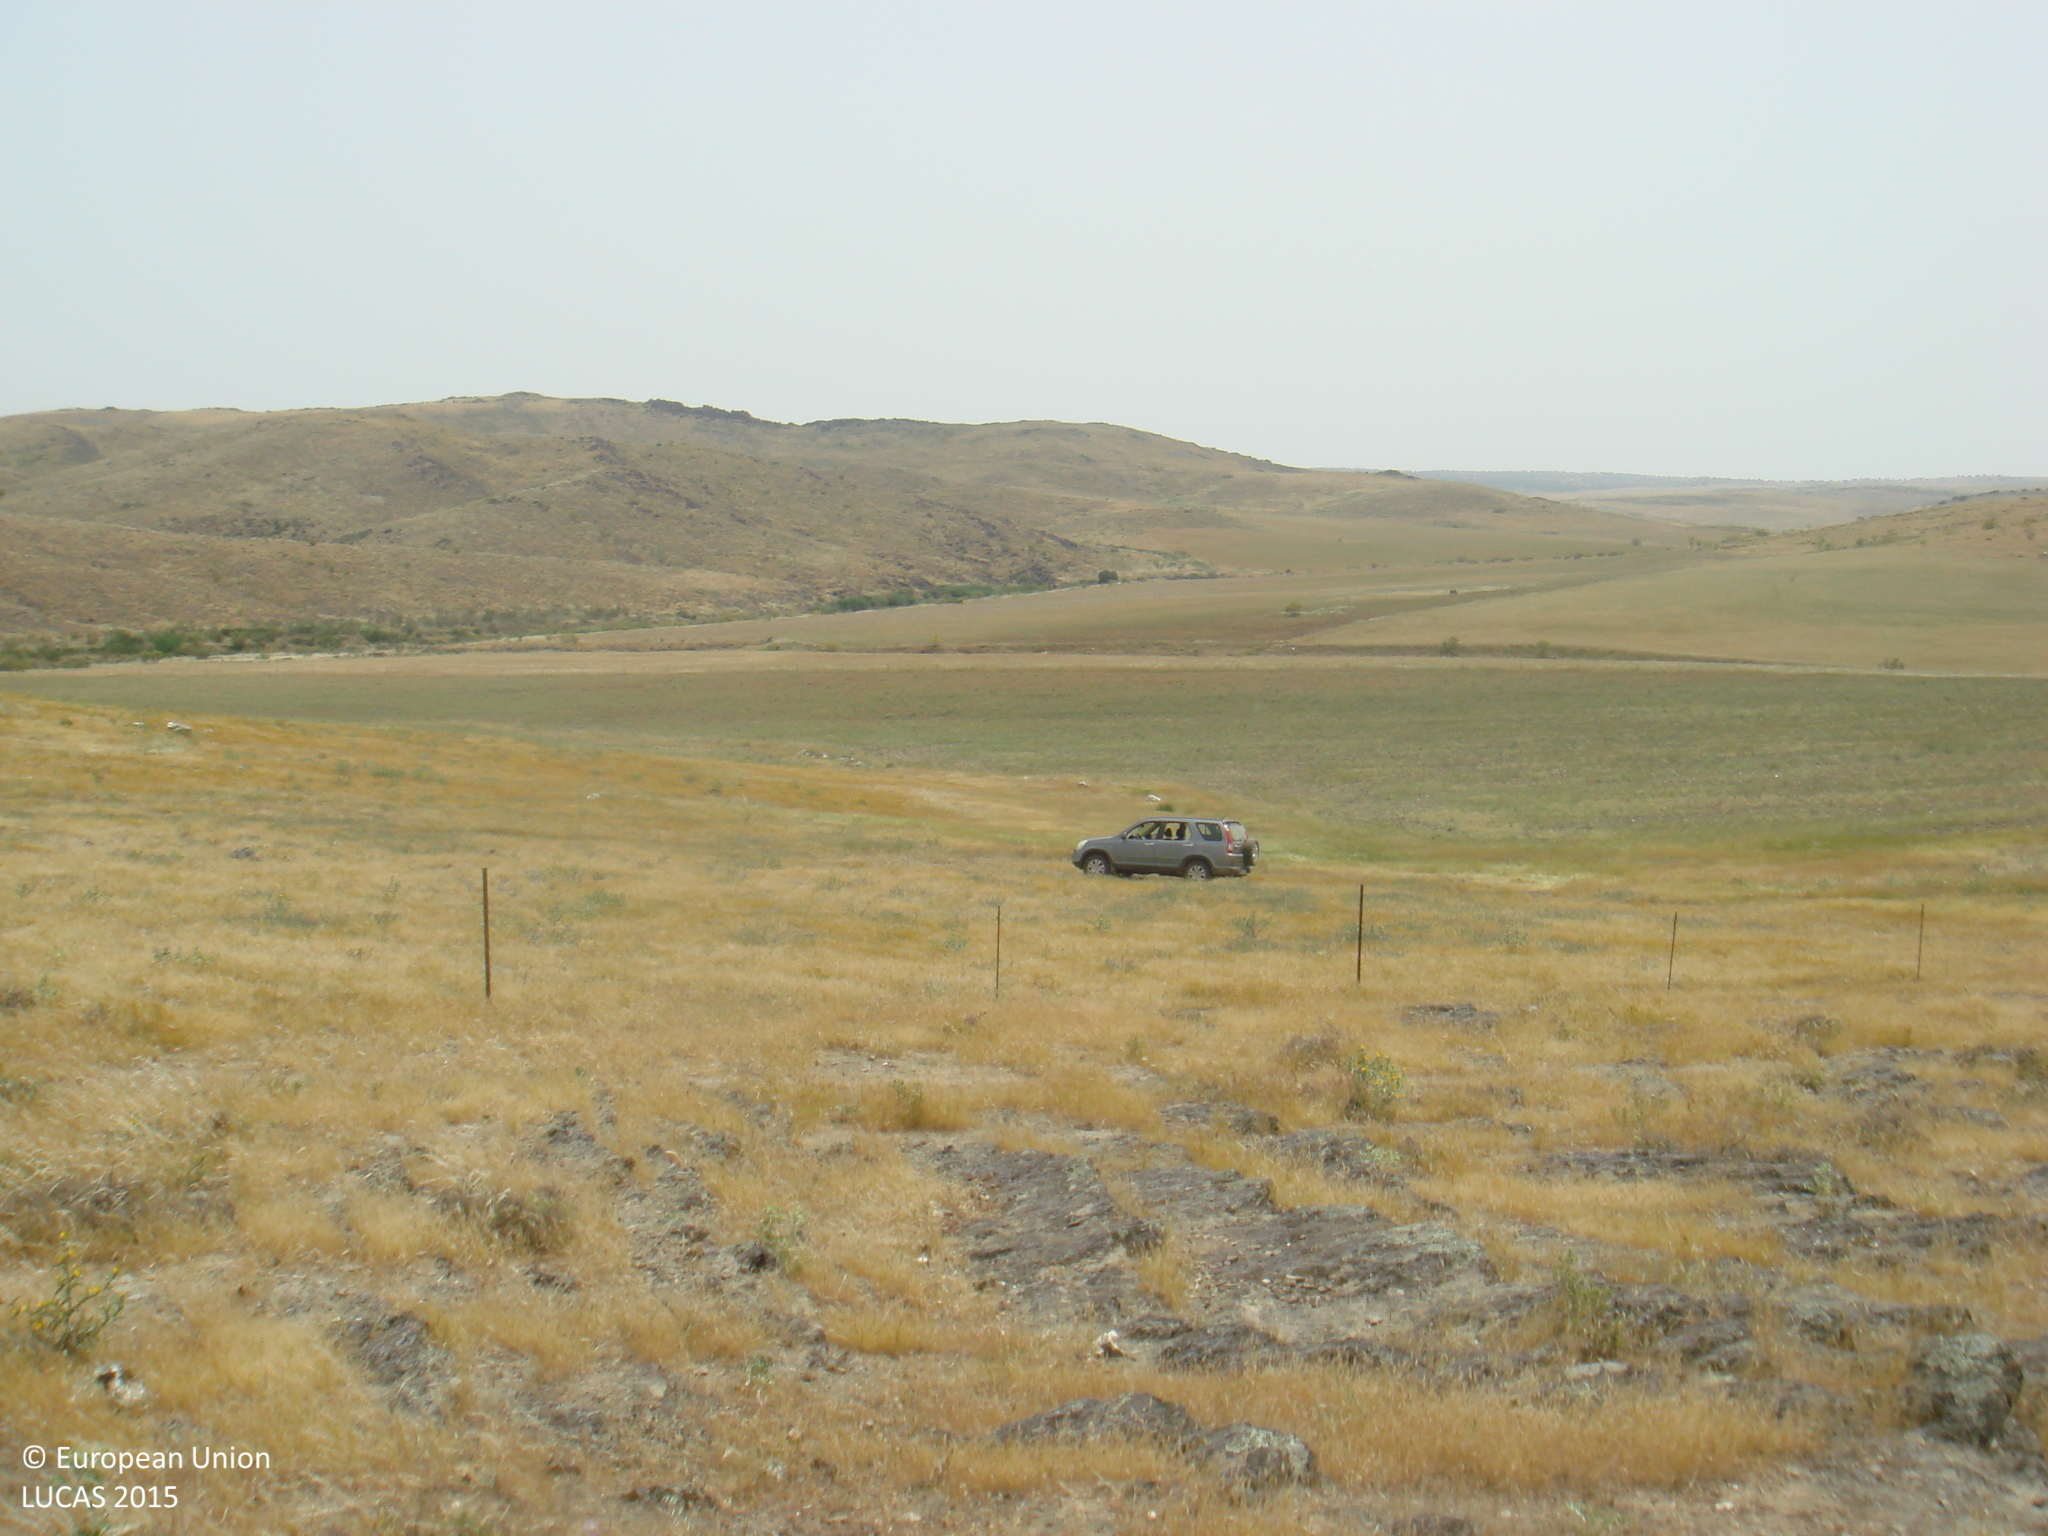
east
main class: Grassland
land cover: Spontaneously vegetated surfaces
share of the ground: > 75 %
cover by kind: herbaceous plants 80 %, consolidated bare surface 20 %
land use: Agriculture (excluding fallow land and kitchen gardens)
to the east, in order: Spontaneously vegetated surfaces; Rock outcrops; Spontaneously vegetated surfaces; Fences; Spontaneously vegetated surfaces; Rock outcrops; Grassland without tree/shrub cover
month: May
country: ES
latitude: 38.6294
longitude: -5.1139
